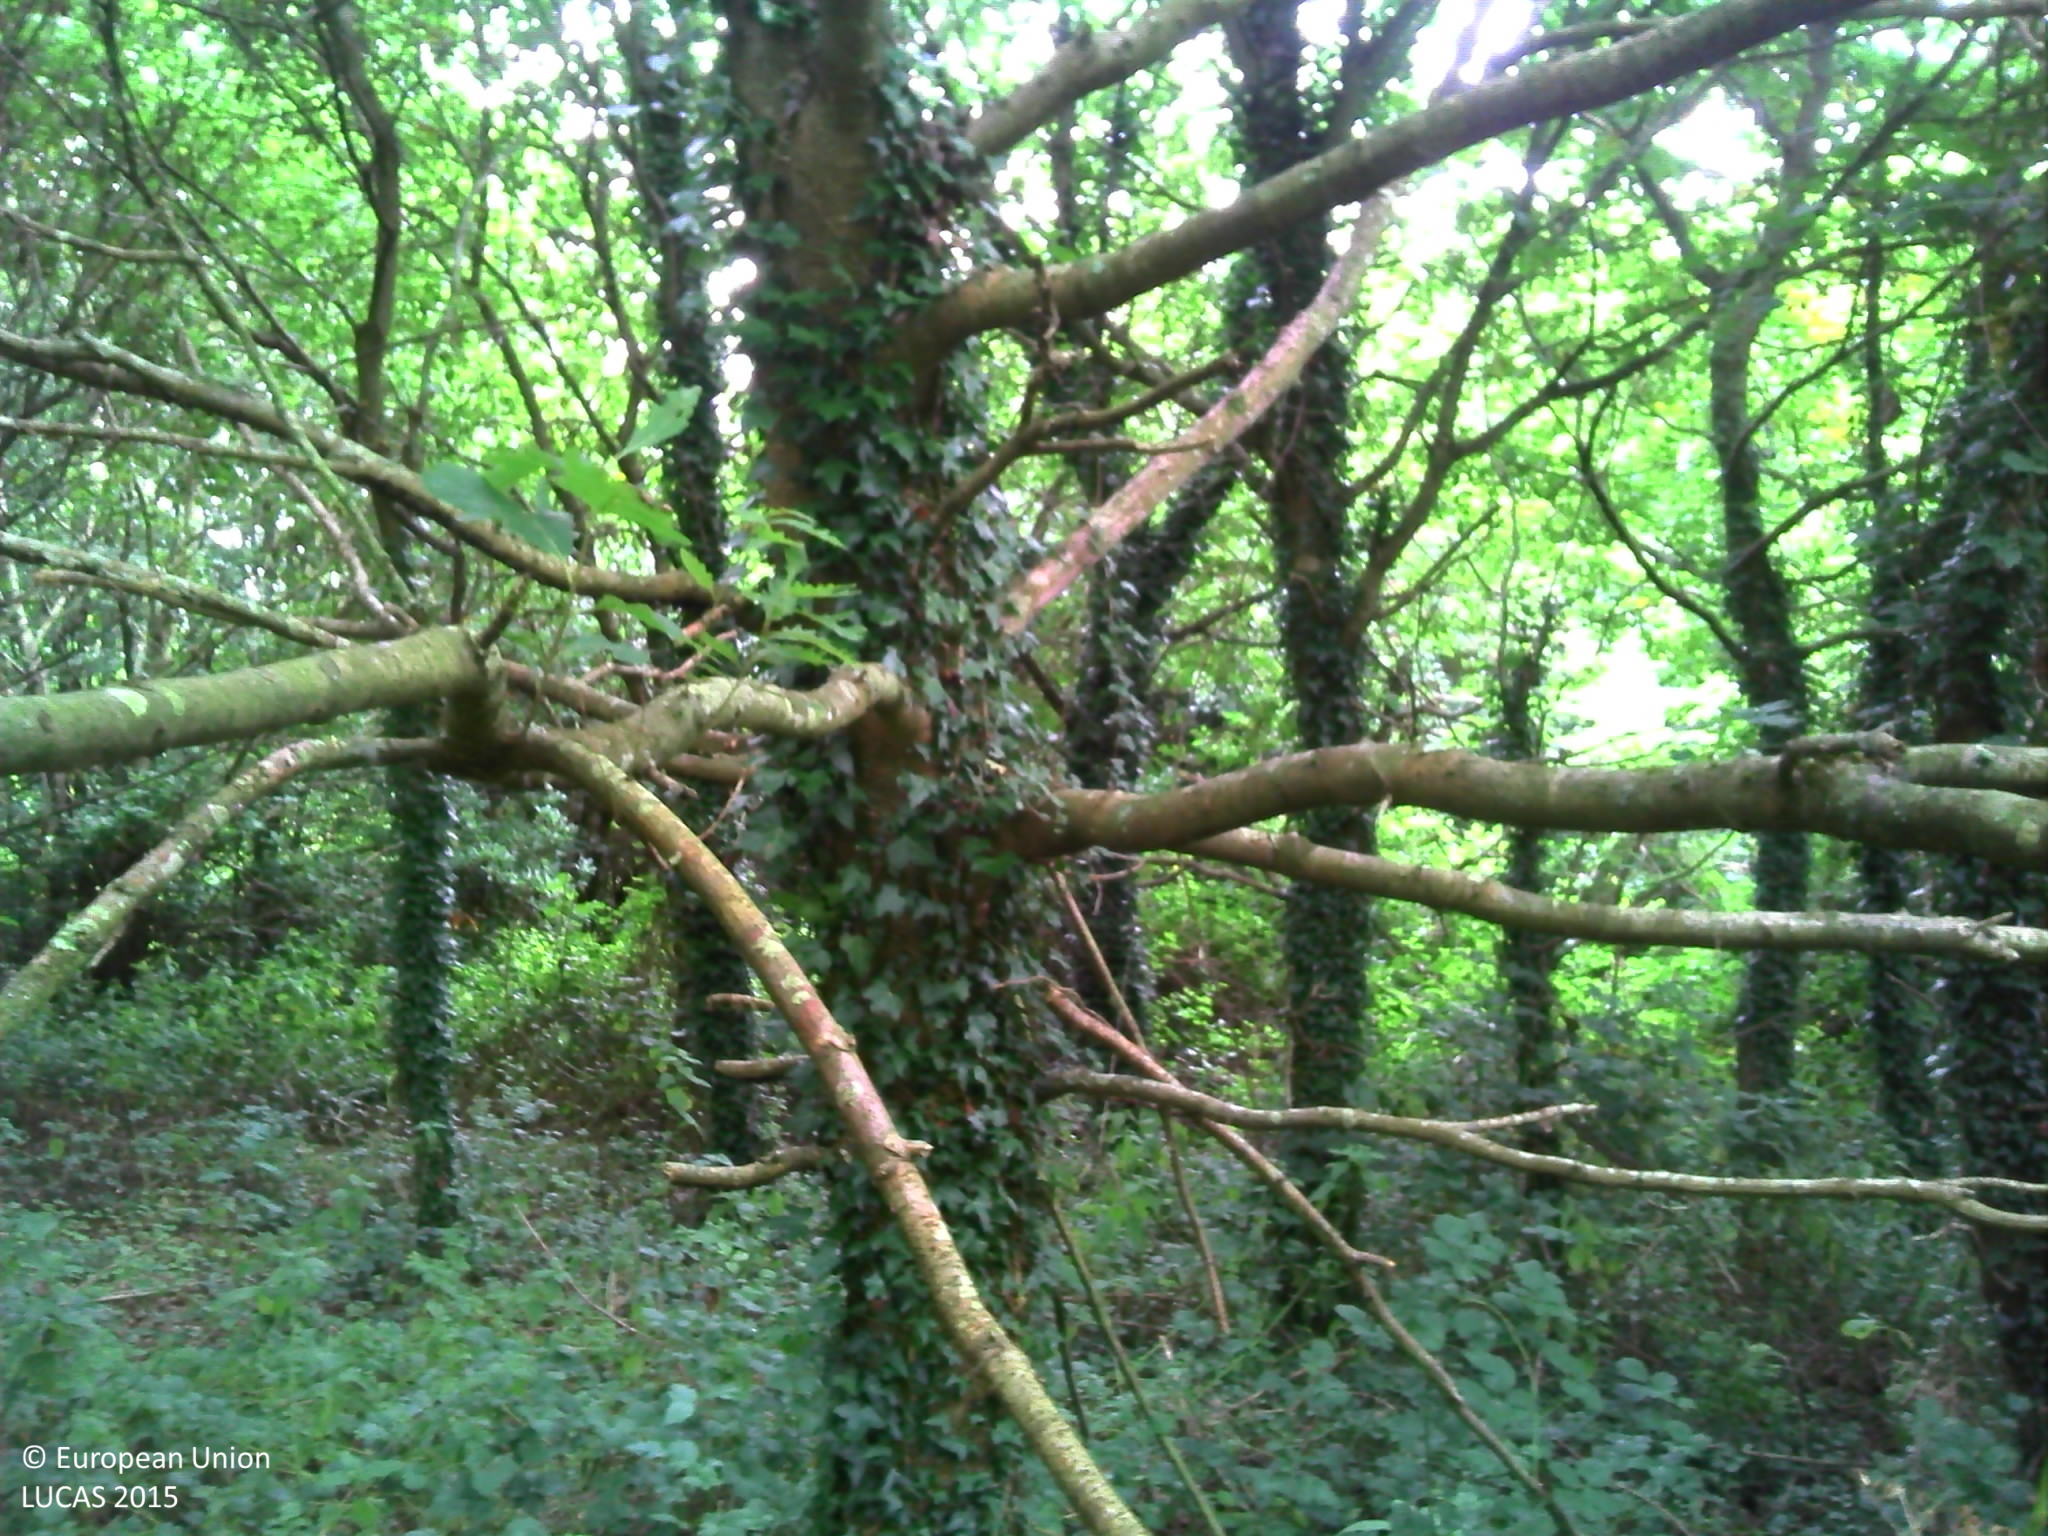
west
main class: Woodland
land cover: Broadleaved woodland
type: acidophilous oak and oak-birch forest
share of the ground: > 75 %
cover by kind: broadleaved forest trees 60 %, shrubs 20 %, herbaceous plants 20 %
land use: Forestry
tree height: > 5 m
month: August
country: FR
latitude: 48.7674
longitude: -3.2592
